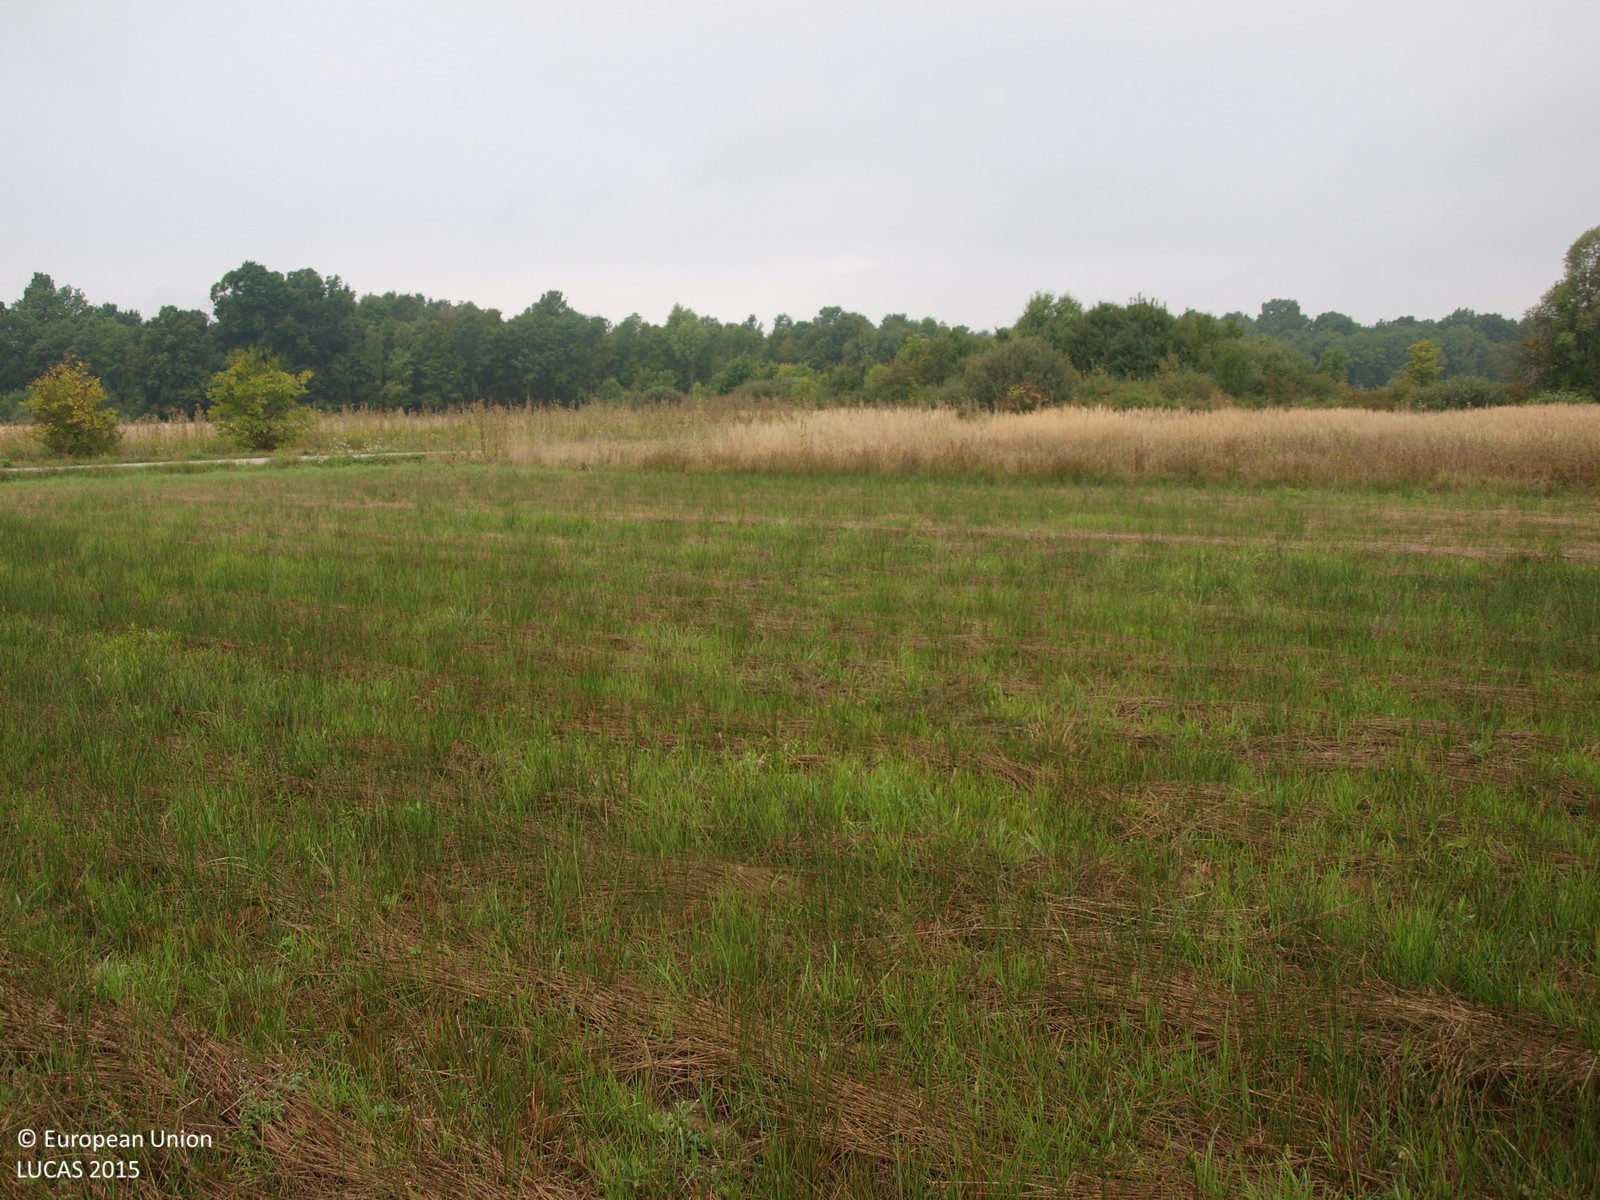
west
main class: Grassland
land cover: Grassland without tree/shrub cover
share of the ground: > 75 %
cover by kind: herbaceous plants 100 %
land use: Agriculture (excluding fallow land and kitchen gardens)
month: August
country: HR
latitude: 45.7703
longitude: 16.2609
